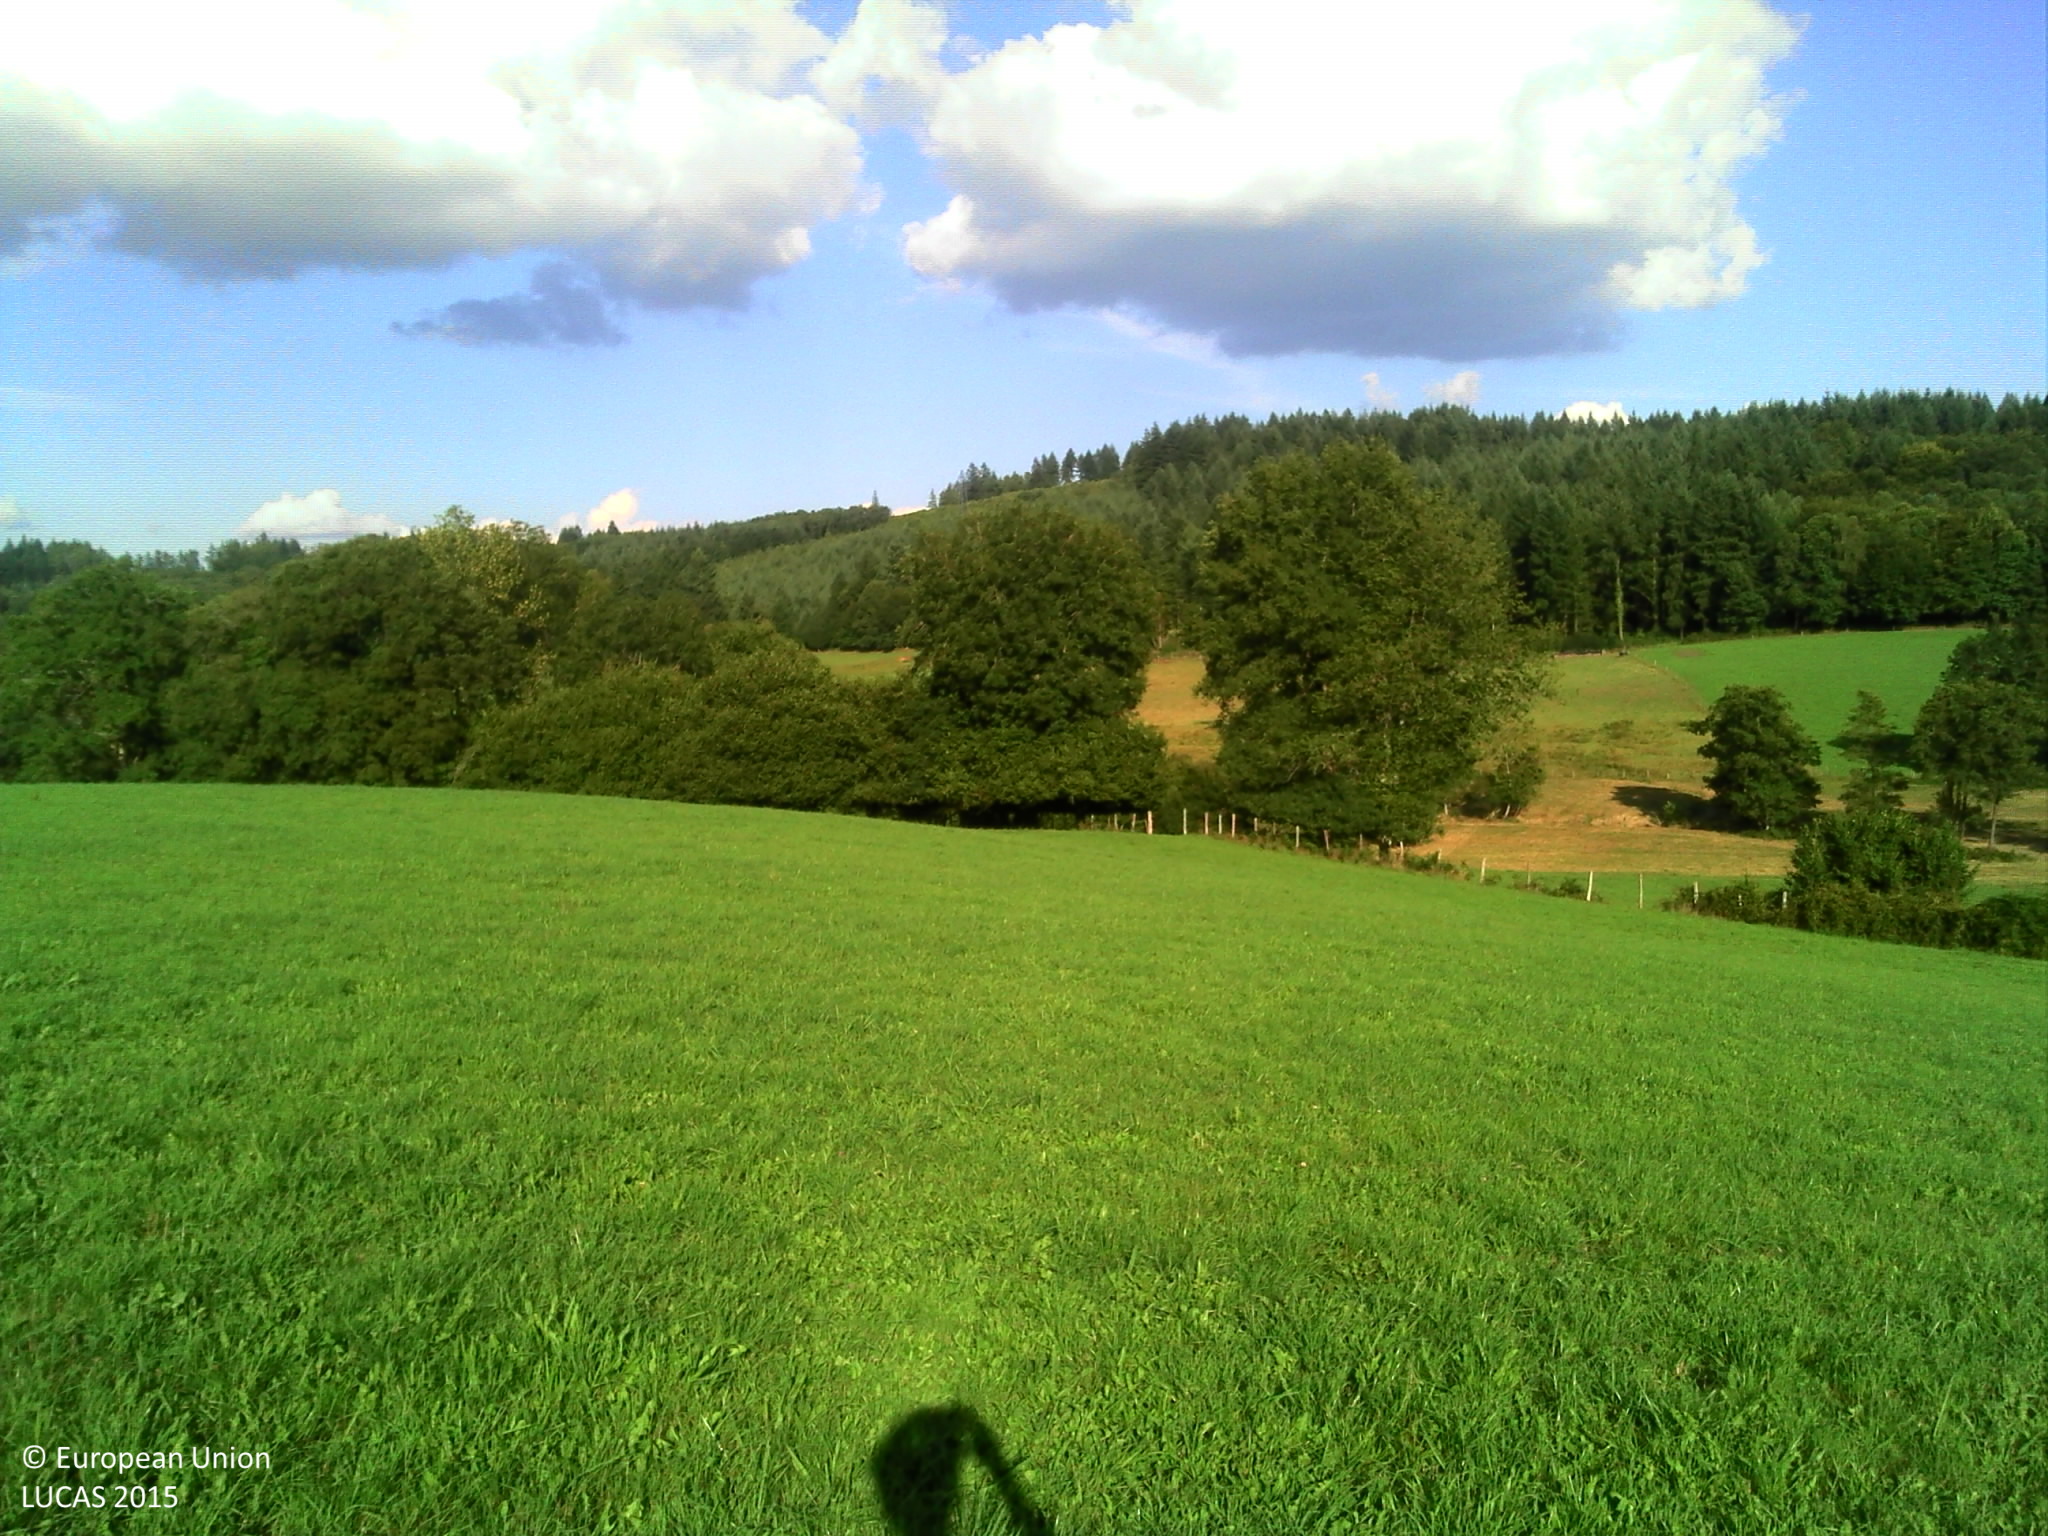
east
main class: Grassland
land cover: Grassland without tree/shrub cover
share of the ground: > 75 %
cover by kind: herbaceous plants 100 %
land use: Agriculture (excluding fallow land and kitchen gardens)
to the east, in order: Grassland without tree/shrub cover; Fences; Broadleaved woodland; Grassland without tree/shrub cover; Broadleaved woodland; Fences; Grassland without tree/shrub cover; Rivers and streams; Grassland without tree/shrub cover; Fences; Managed hedges; Ditches and canals; Fences; Grassland without tree/shrub cover
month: August
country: FR
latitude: 45.9019
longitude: 1.7051
